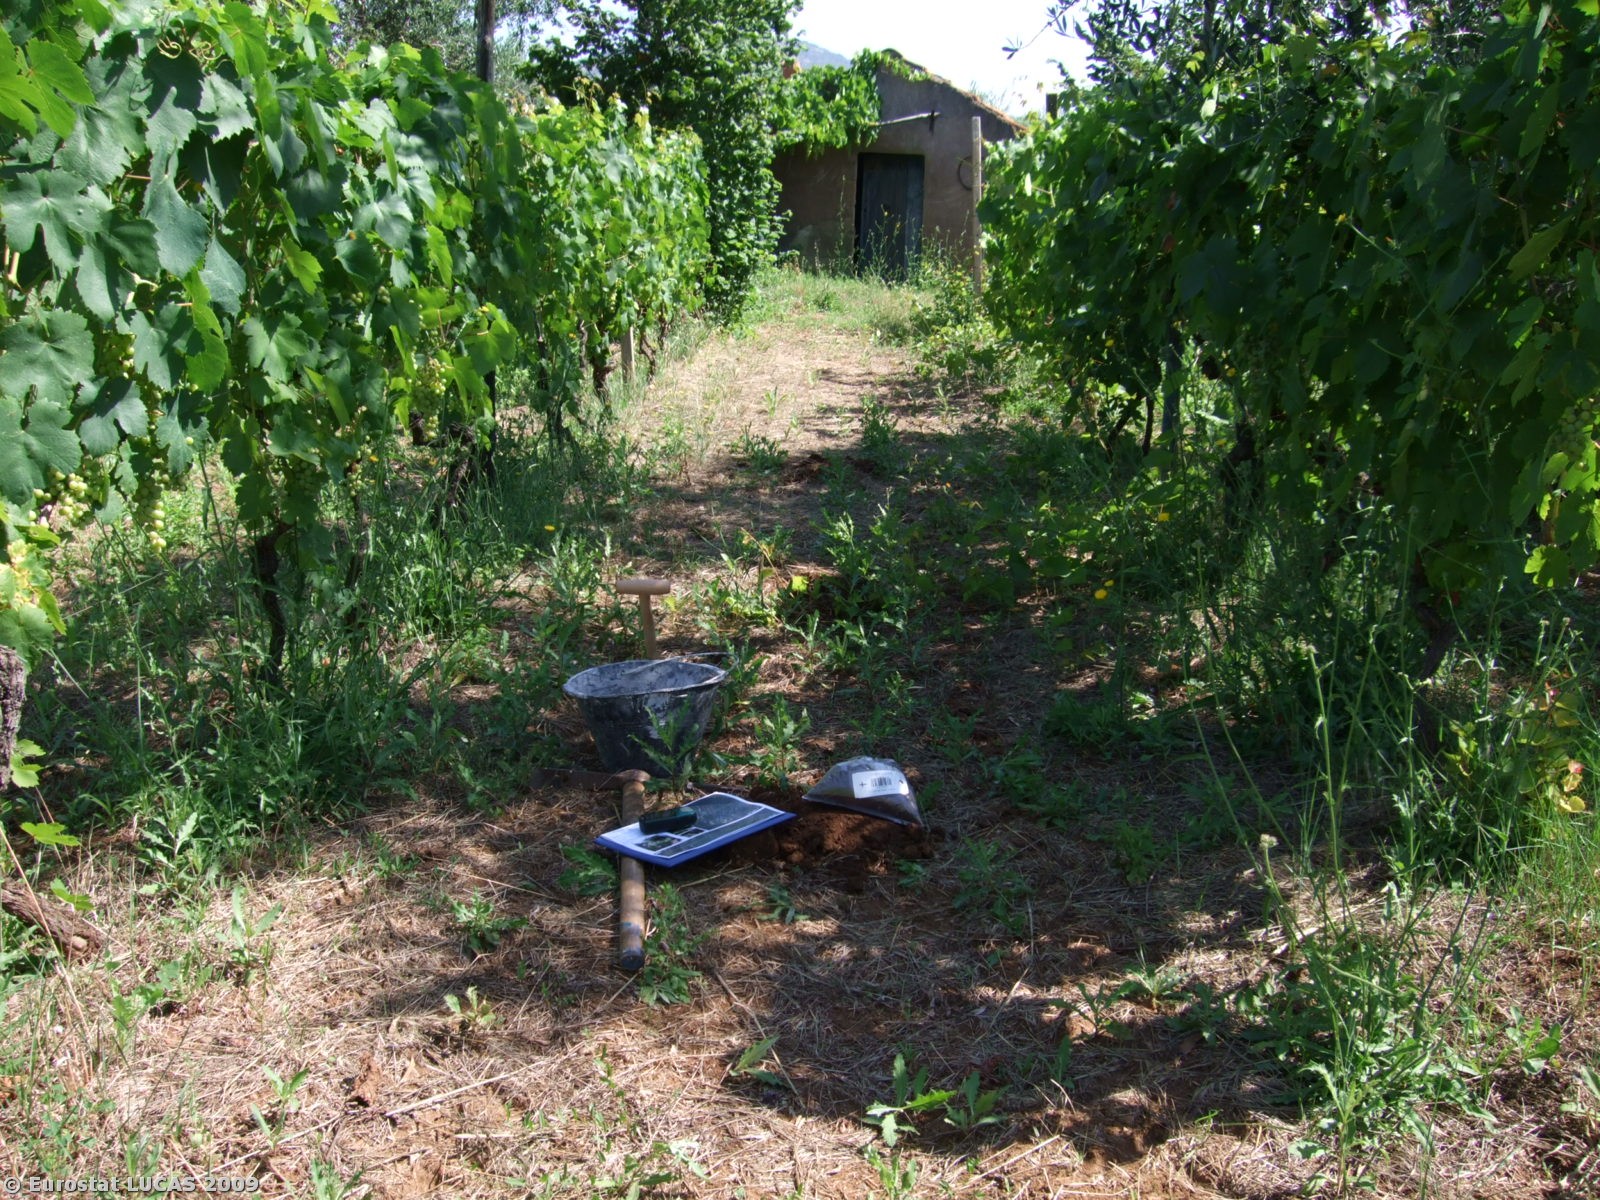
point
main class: Cropland
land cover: Vineyards
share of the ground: 25 - 50 %
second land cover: Olive groves
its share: 25 - 50 %
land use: Agriculture (excluding fallow land and kitchen gardens)
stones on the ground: < 10 %
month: July
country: IT
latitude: 41.8923
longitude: 12.7979
